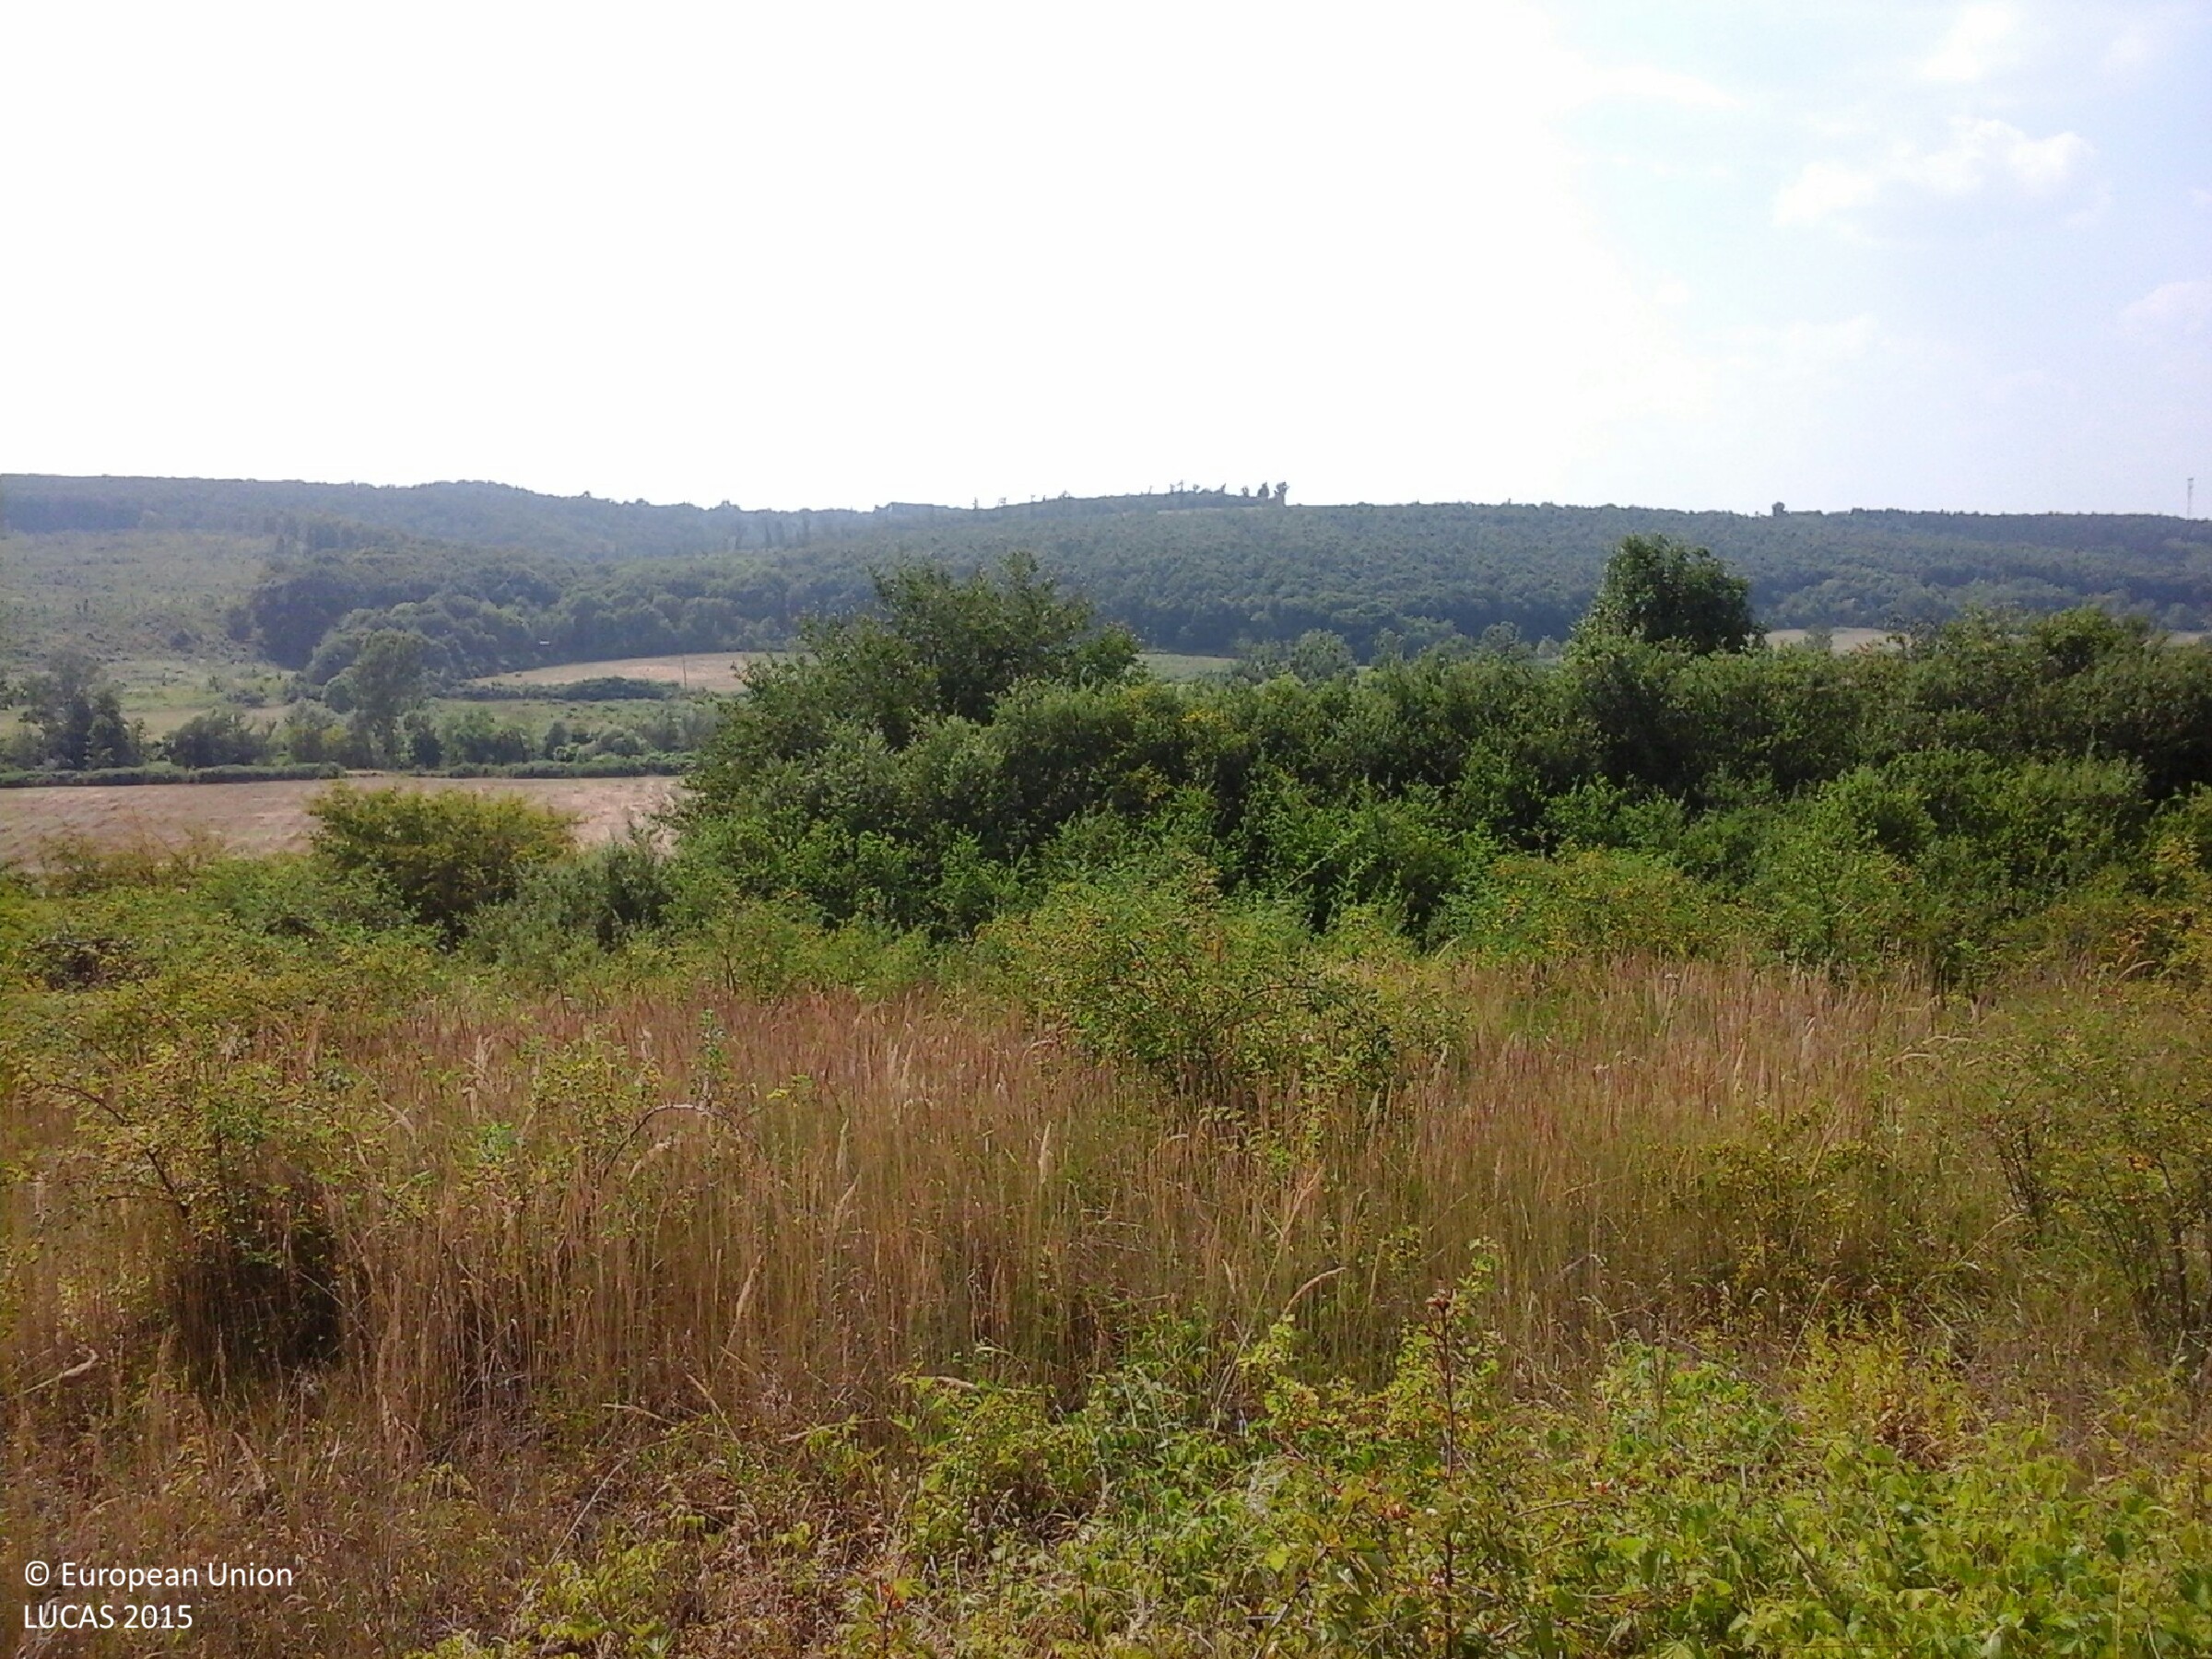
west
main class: Shrubland
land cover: Shrubland without tree cover
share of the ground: 50 - 75 %
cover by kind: shrubs 50 %, herbaceous plants 50 %
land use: Abandoned areas
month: July
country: HU
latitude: 47.8455
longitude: 20.3335
